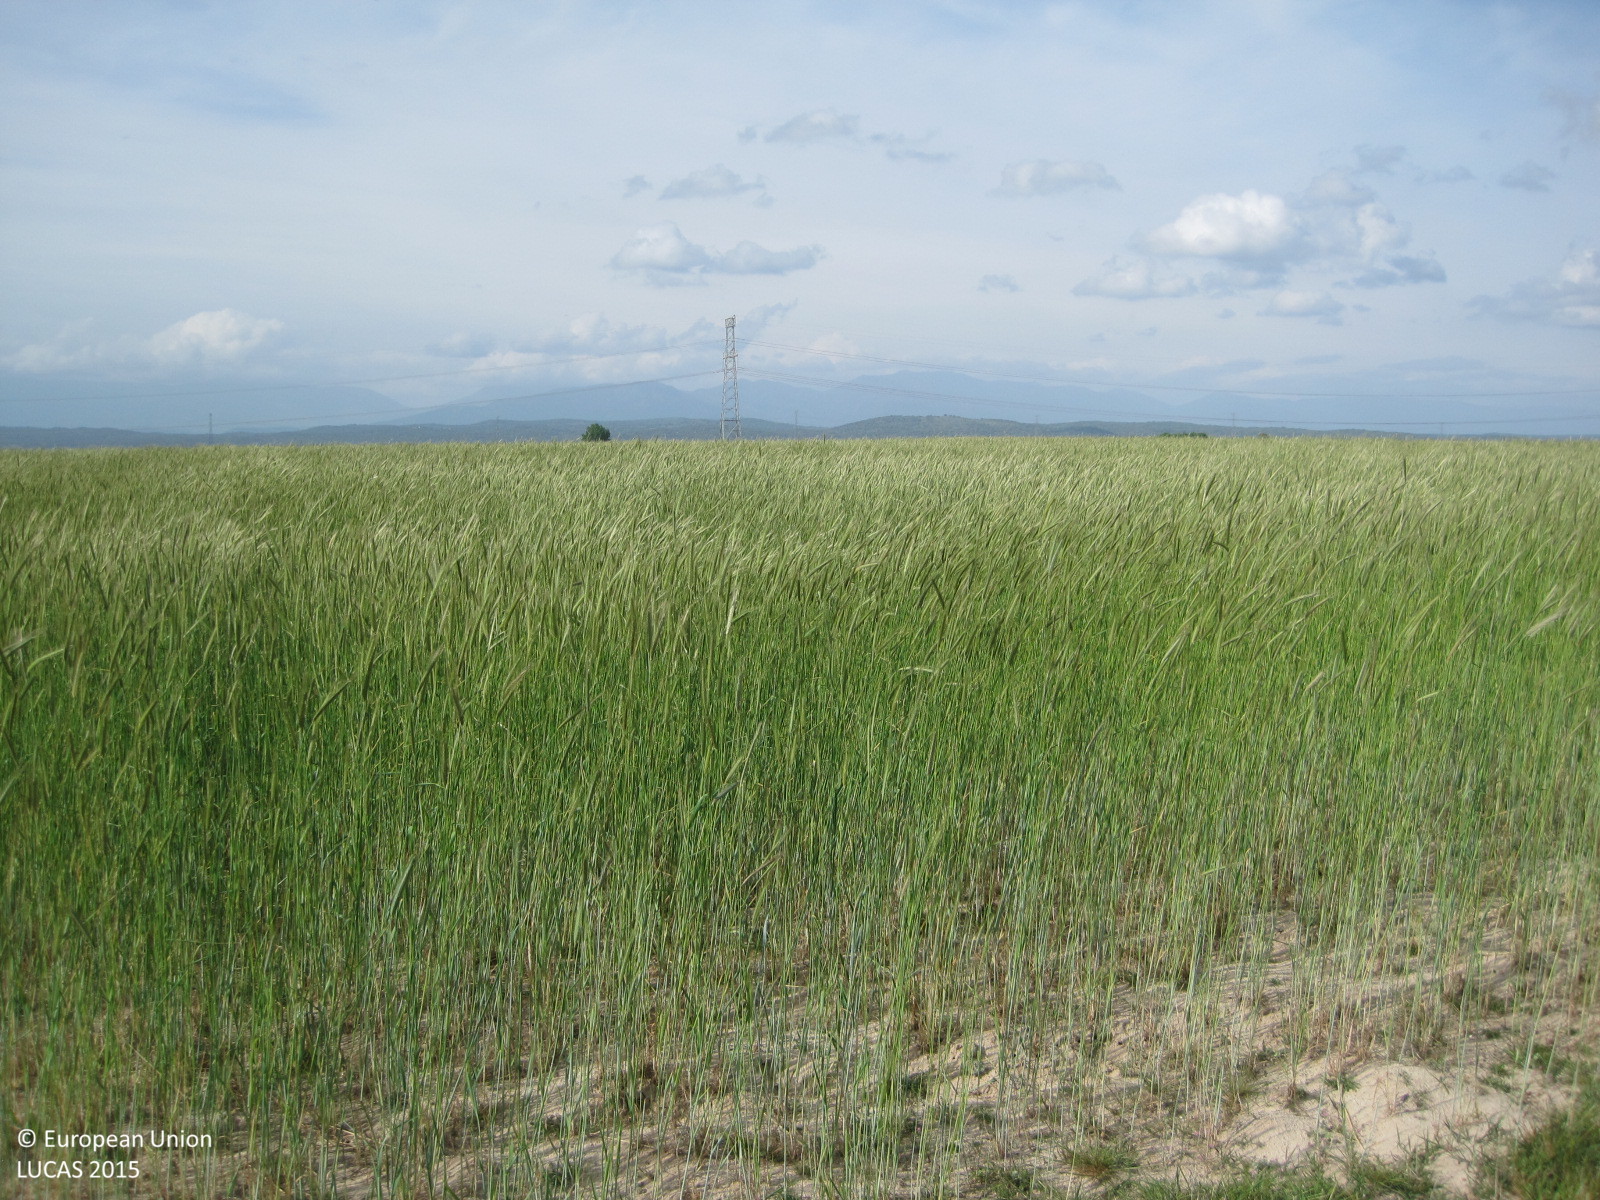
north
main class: Grassland
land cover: Grassland without tree/shrub cover
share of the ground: > 75 %
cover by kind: herbaceous plants 100 %
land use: Agriculture (excluding fallow land and kitchen gardens)
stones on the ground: 10 - 25 %
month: April
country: ES
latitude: 40.0087
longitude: -4.9873
